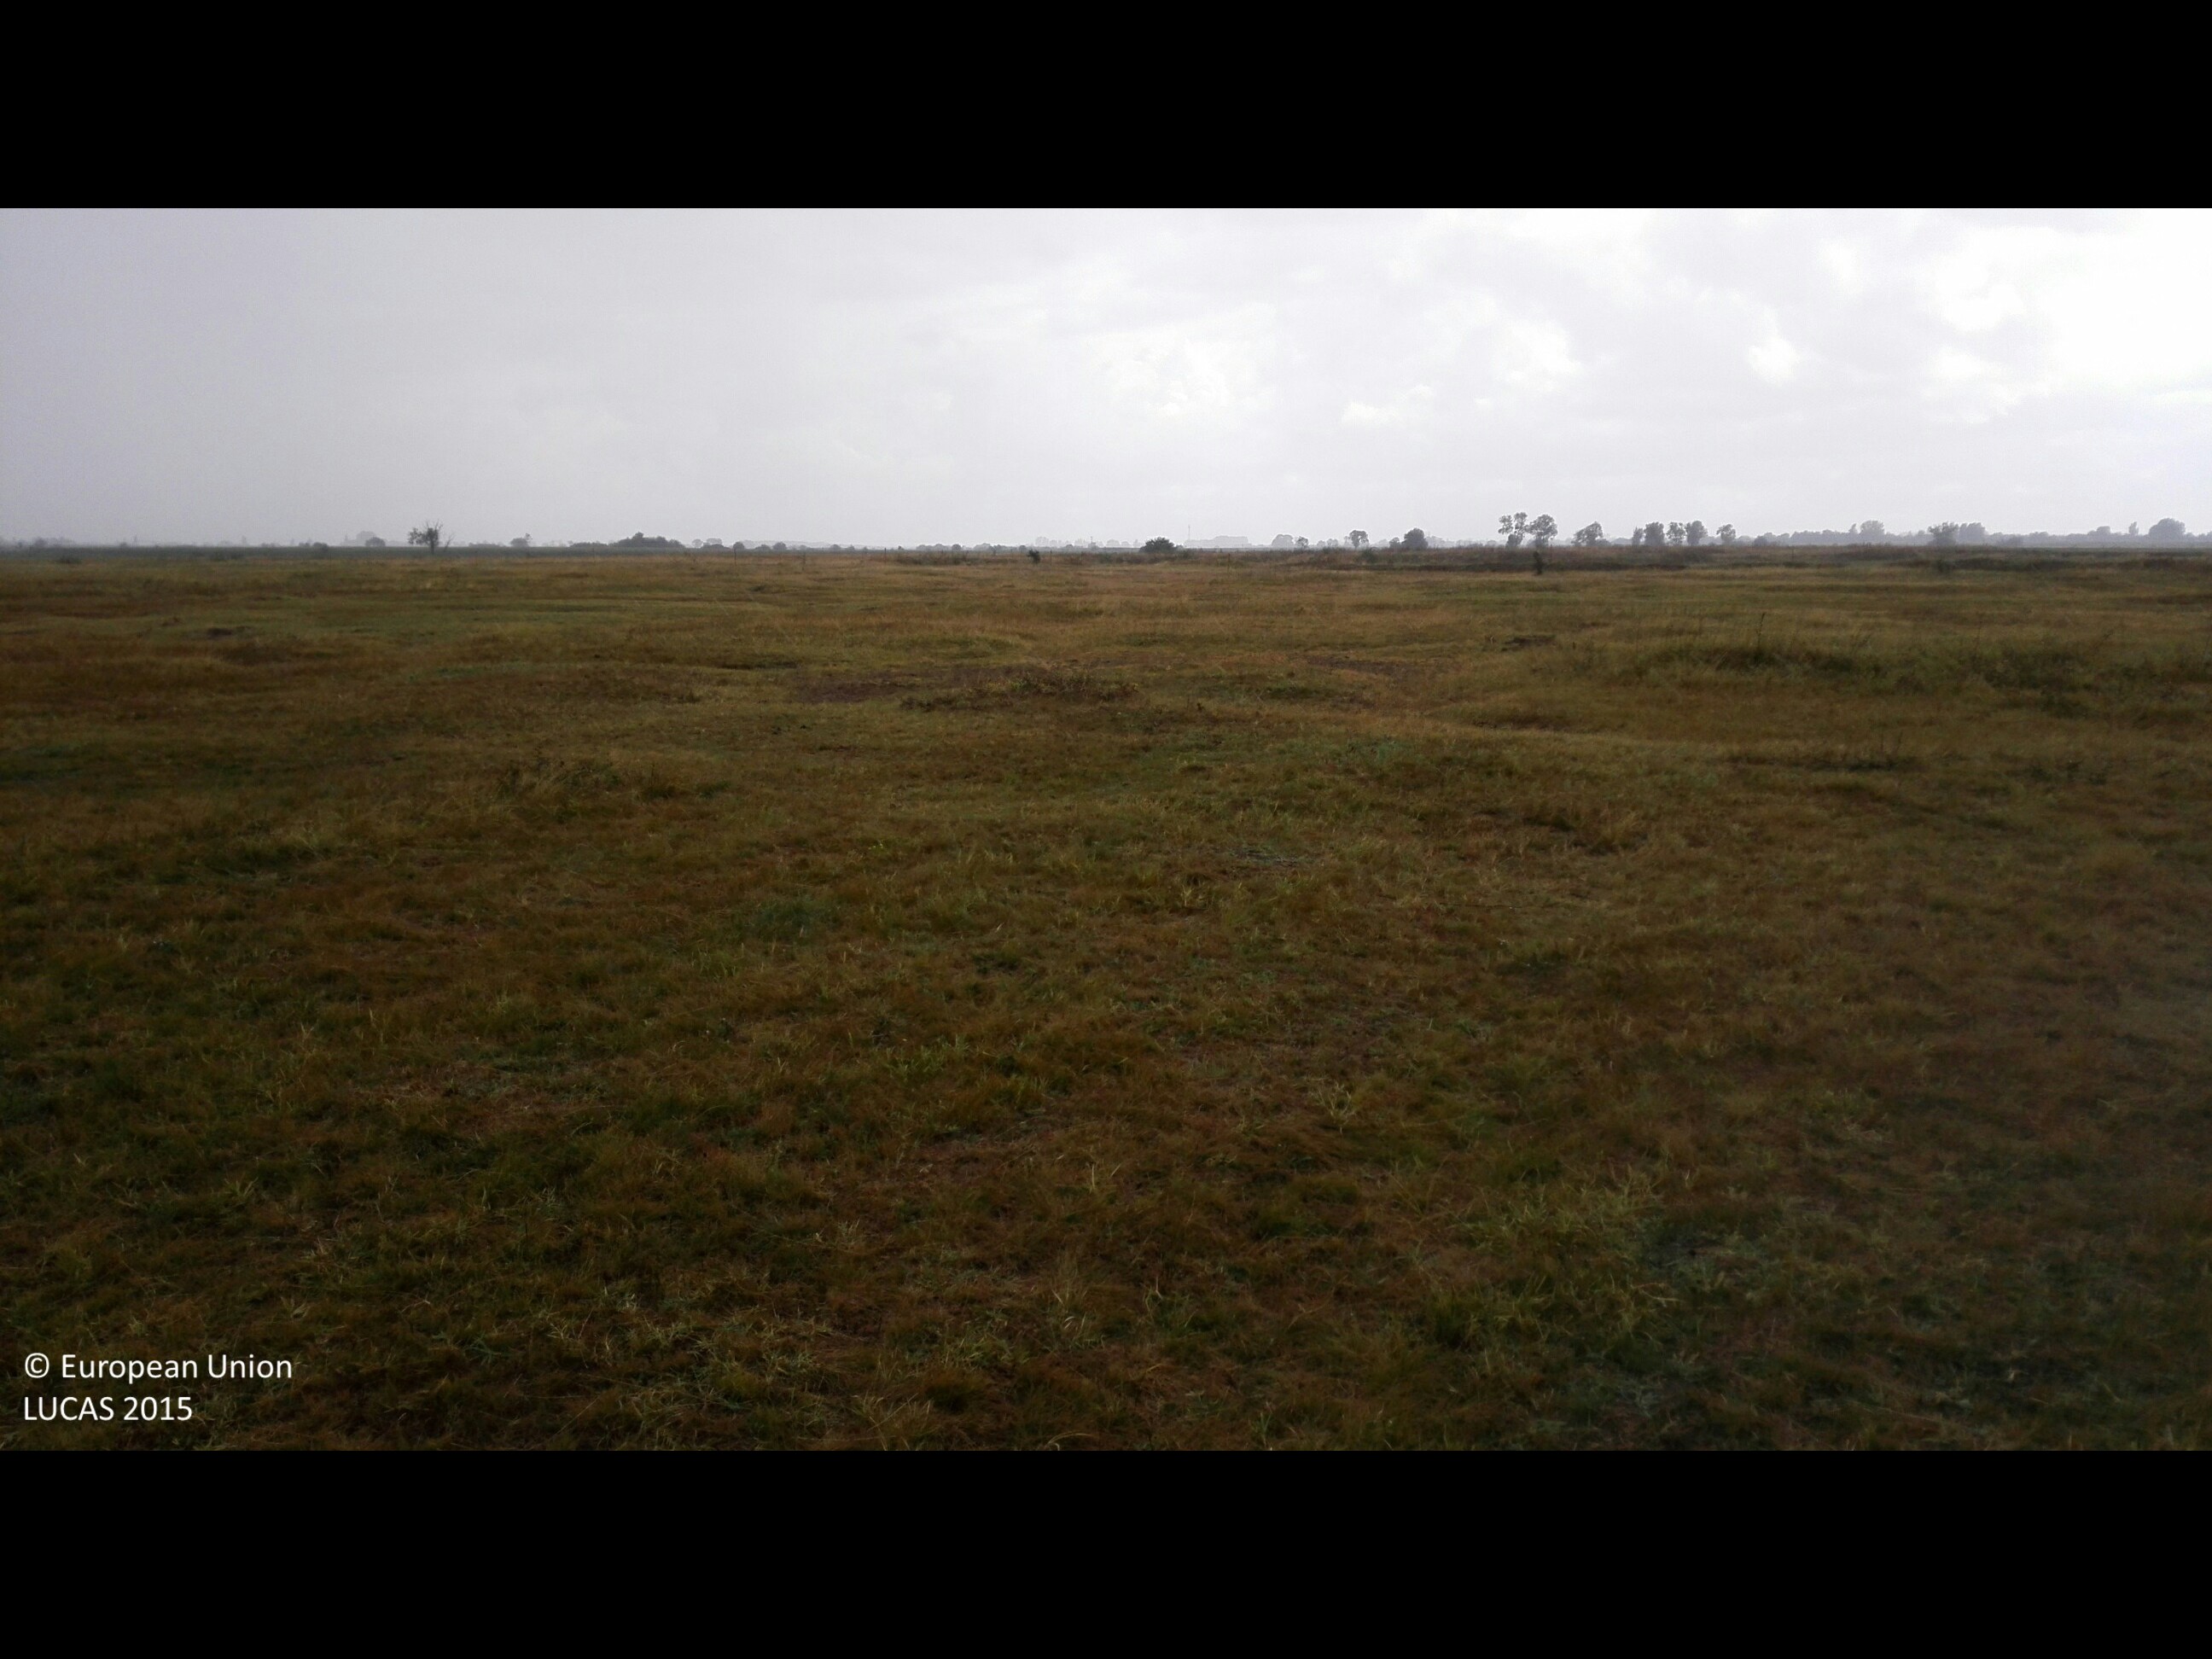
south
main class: Grassland
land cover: Grassland without tree/shrub cover
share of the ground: > 75 %
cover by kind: herbaceous plants 100 %
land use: Agriculture (excluding fallow land and kitchen gardens)
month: August
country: HU
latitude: 47.3458
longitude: 21.6794
